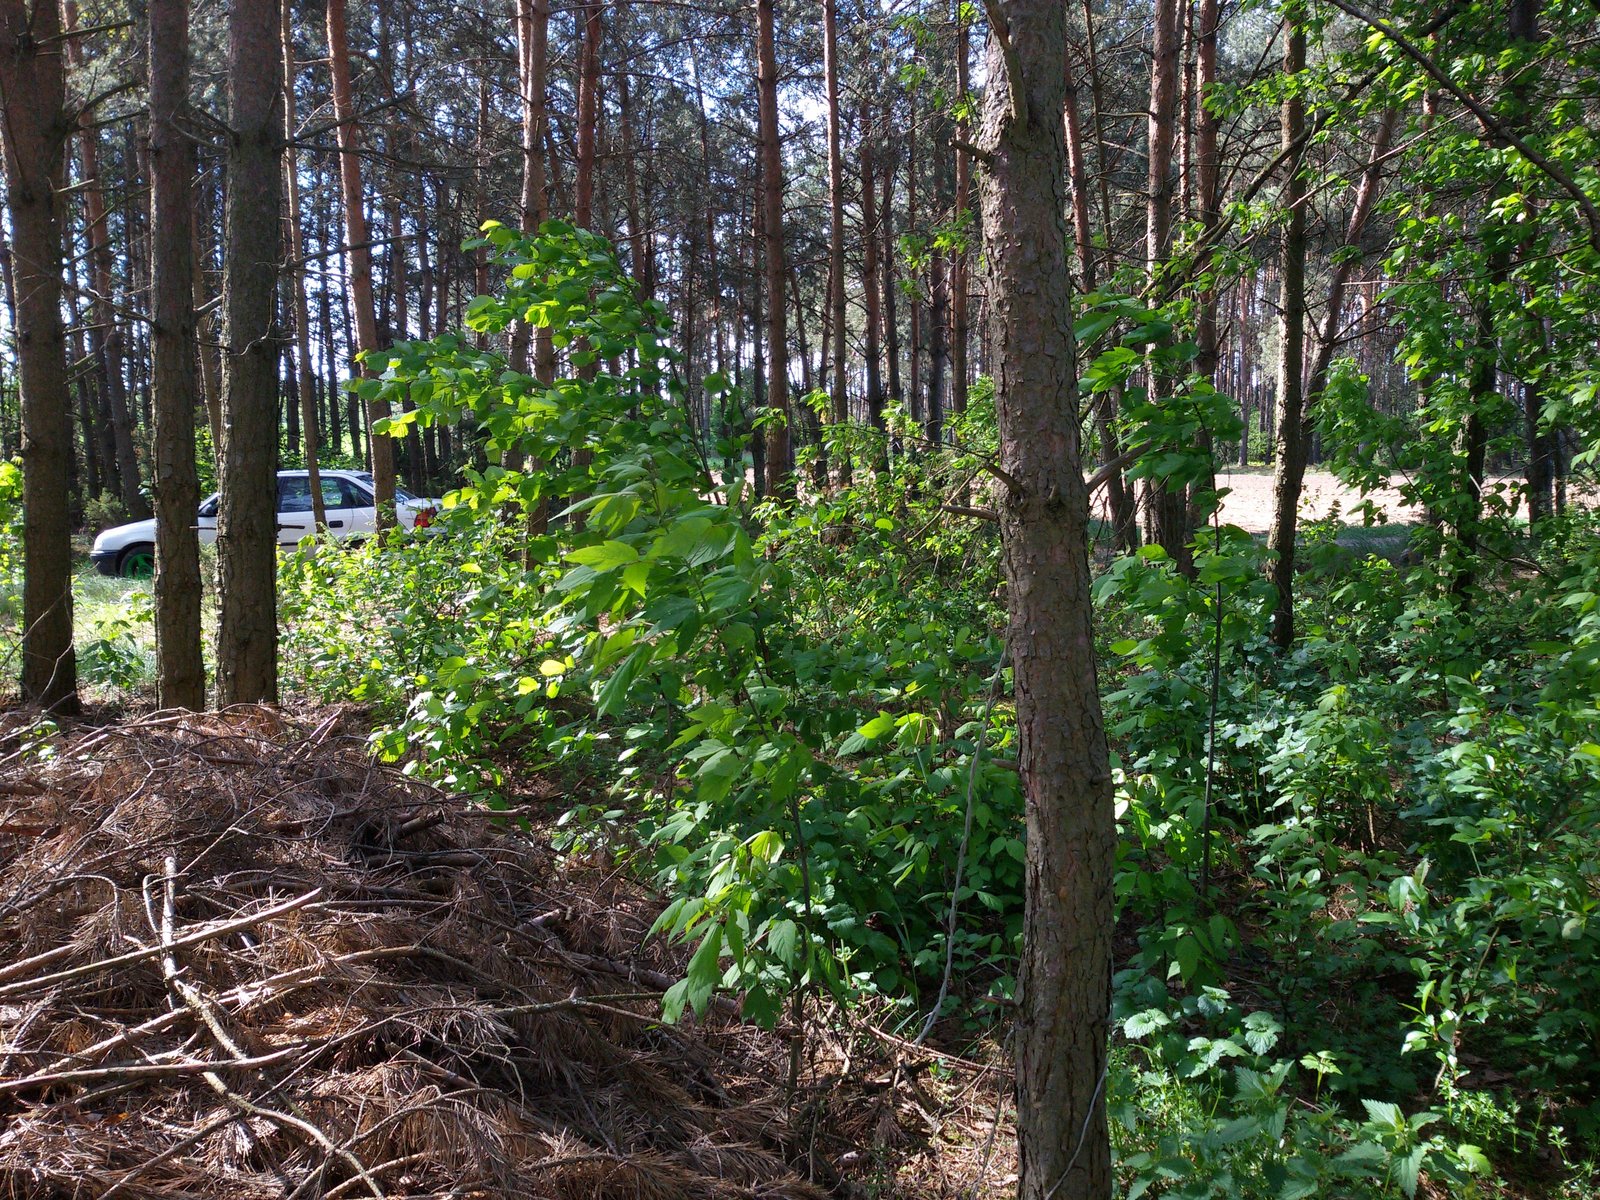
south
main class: Woodland
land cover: Pine dominated coniferous woodland
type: hemiboreal forest and nemoral coniferous forest and mixed broadleaved-coniferous forest
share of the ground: > 75 %
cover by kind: coniferous forest trees 75 %, shrubs 10 %, herbaceous plants 10 %, lichens and mosses 5 %
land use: Forestry
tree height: > 5 m
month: May
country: PL
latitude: 53.0172
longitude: 22.3918
